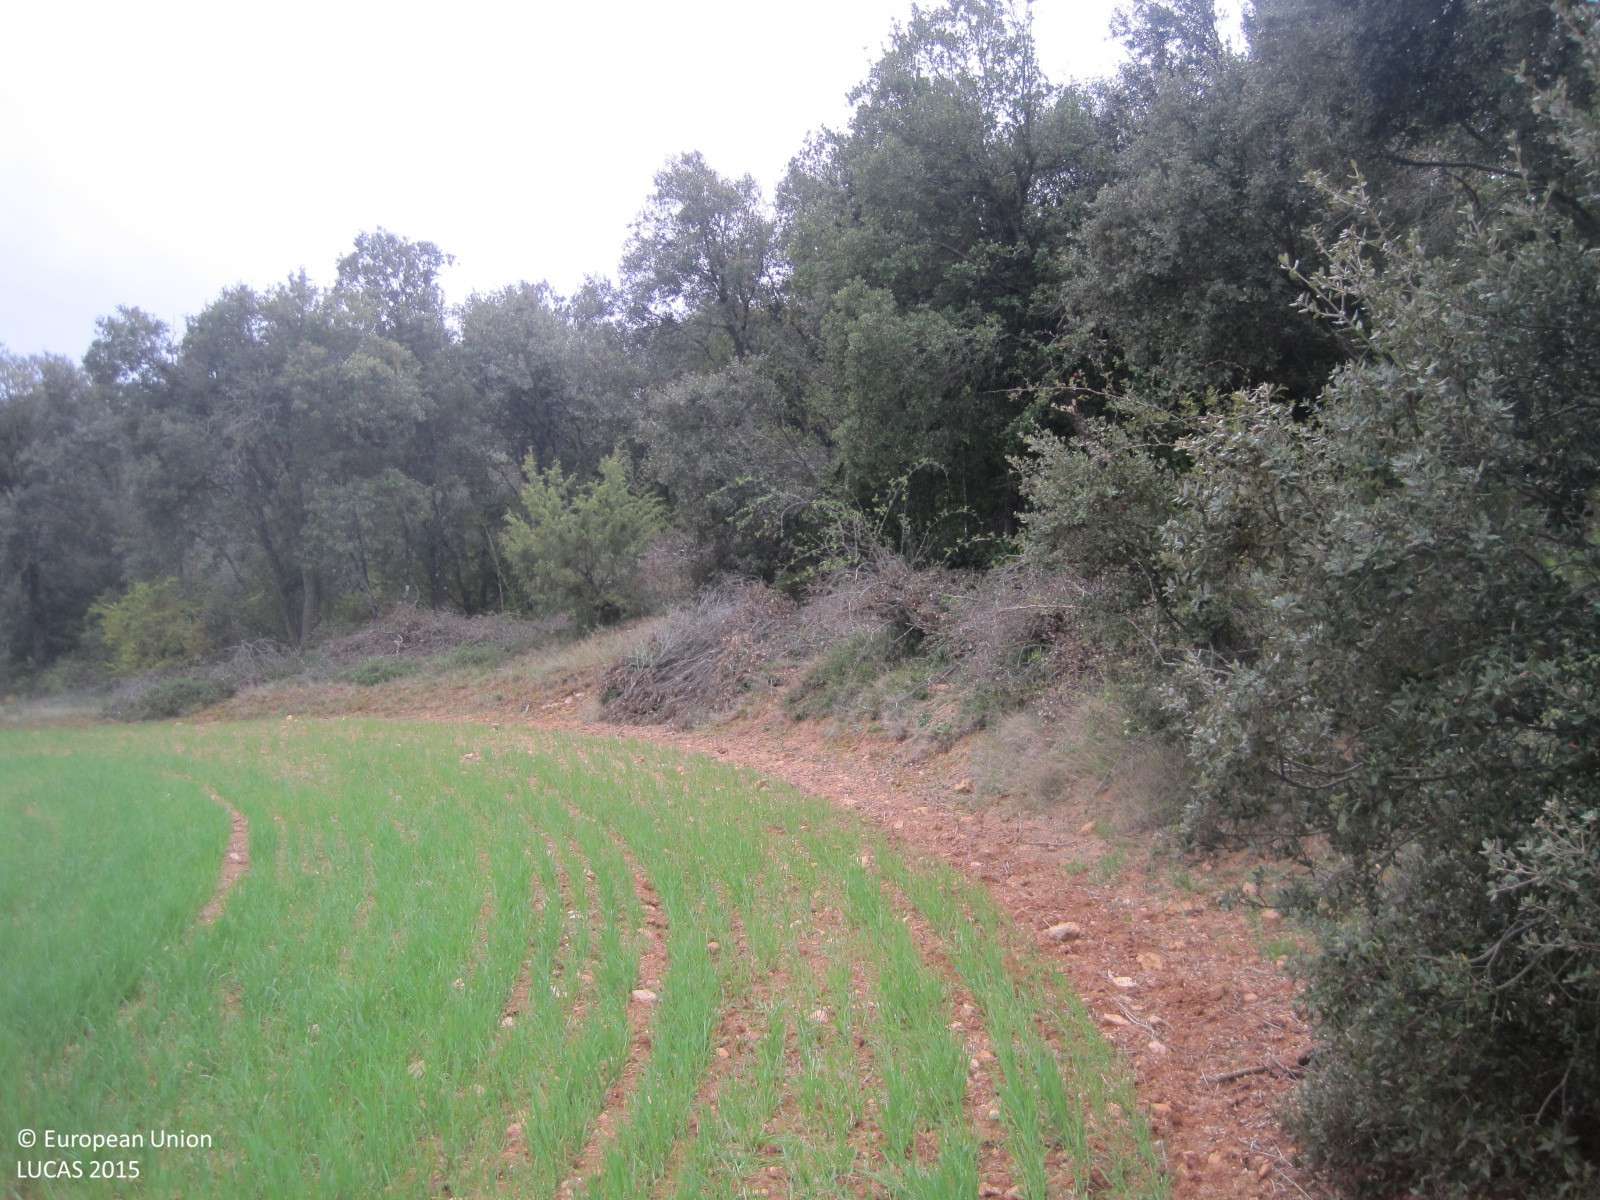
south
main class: Cropland
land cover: Barley
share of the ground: > 75 %
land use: Agriculture (excluding fallow land and kitchen gardens)
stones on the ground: > 50 %
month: April
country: ES
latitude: 42.6428
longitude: -2.2034
